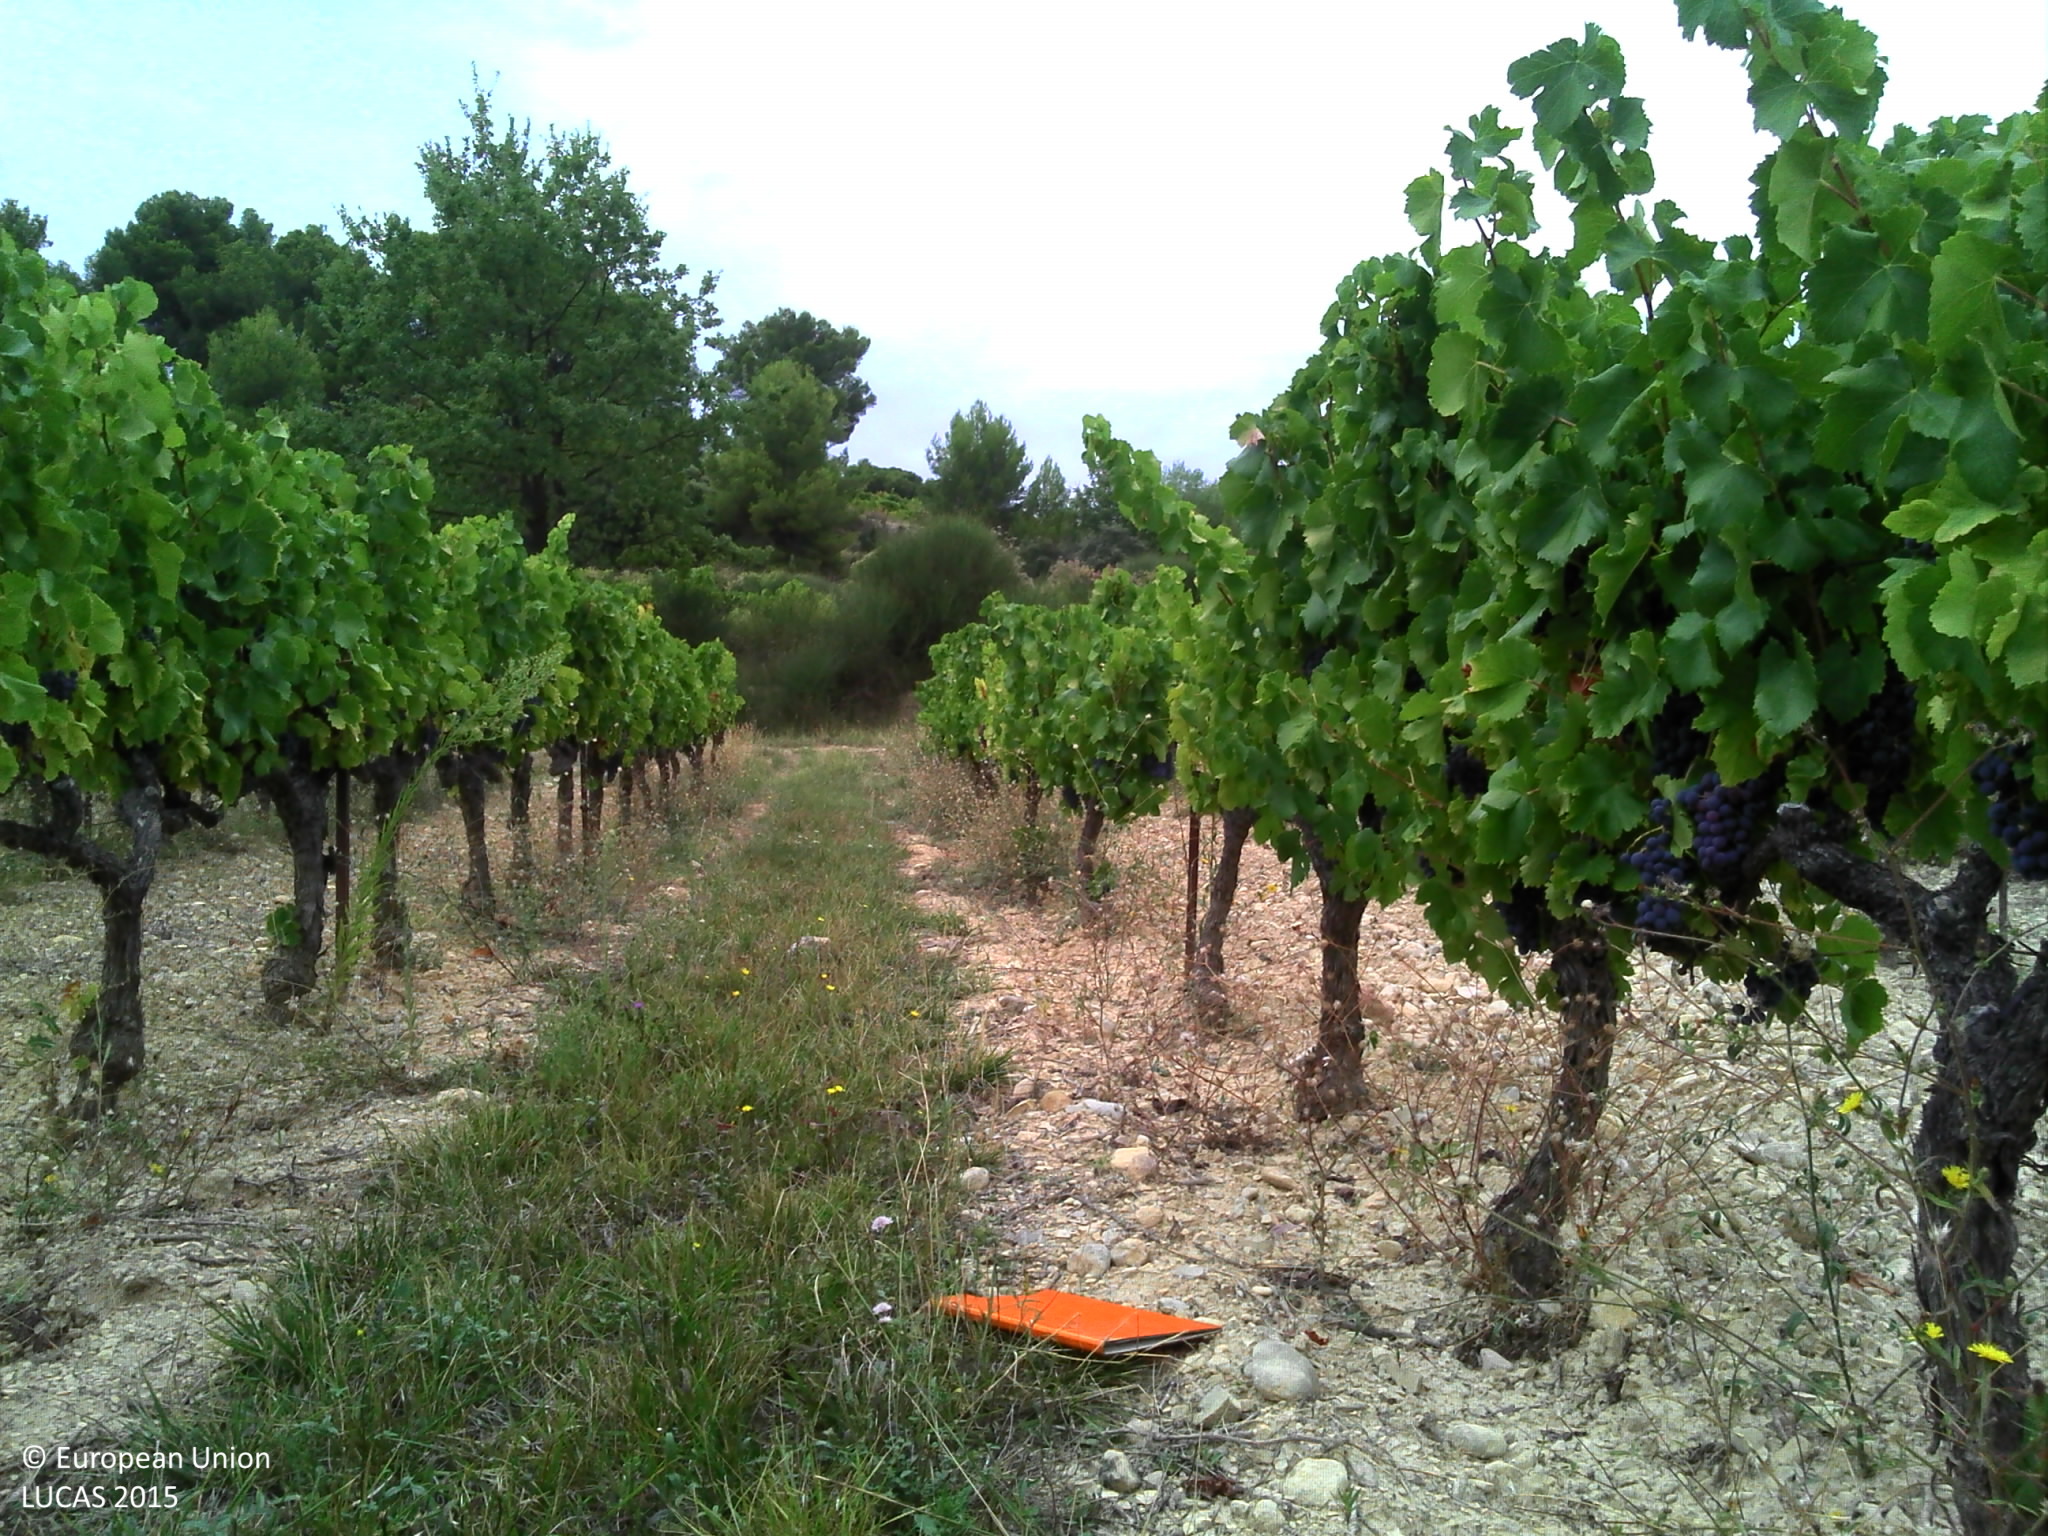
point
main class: Cropland
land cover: Vineyards
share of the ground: 50 - 75 %
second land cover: Grassland without tree/shrub cover
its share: 10 - 25 %
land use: Agriculture (excluding fallow land and kitchen gardens)
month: September
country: FR
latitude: 44.3422
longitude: 5.0780
